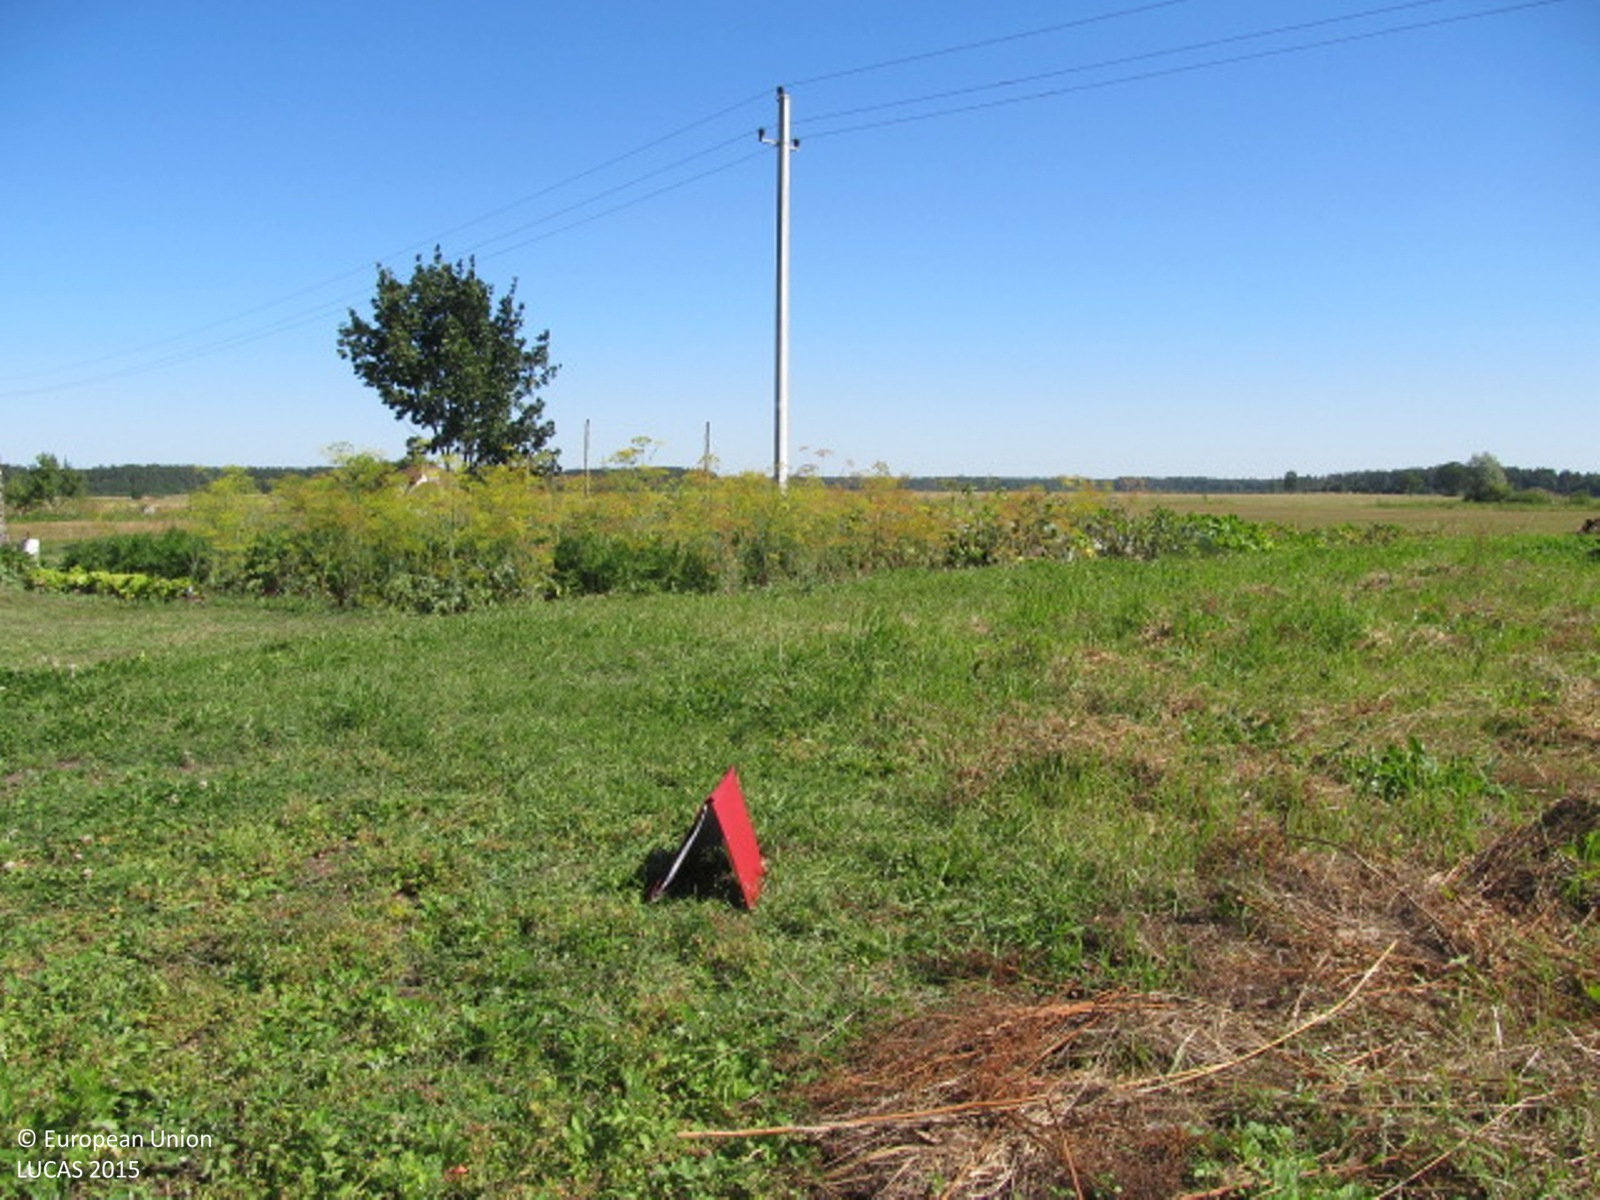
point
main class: Grassland
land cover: Grassland without tree/shrub cover
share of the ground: > 75 %
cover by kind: herbaceous plants 100 %
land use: Agriculture (excluding fallow land and kitchen gardens)
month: August
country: LT
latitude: 56.1884
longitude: 22.5471
